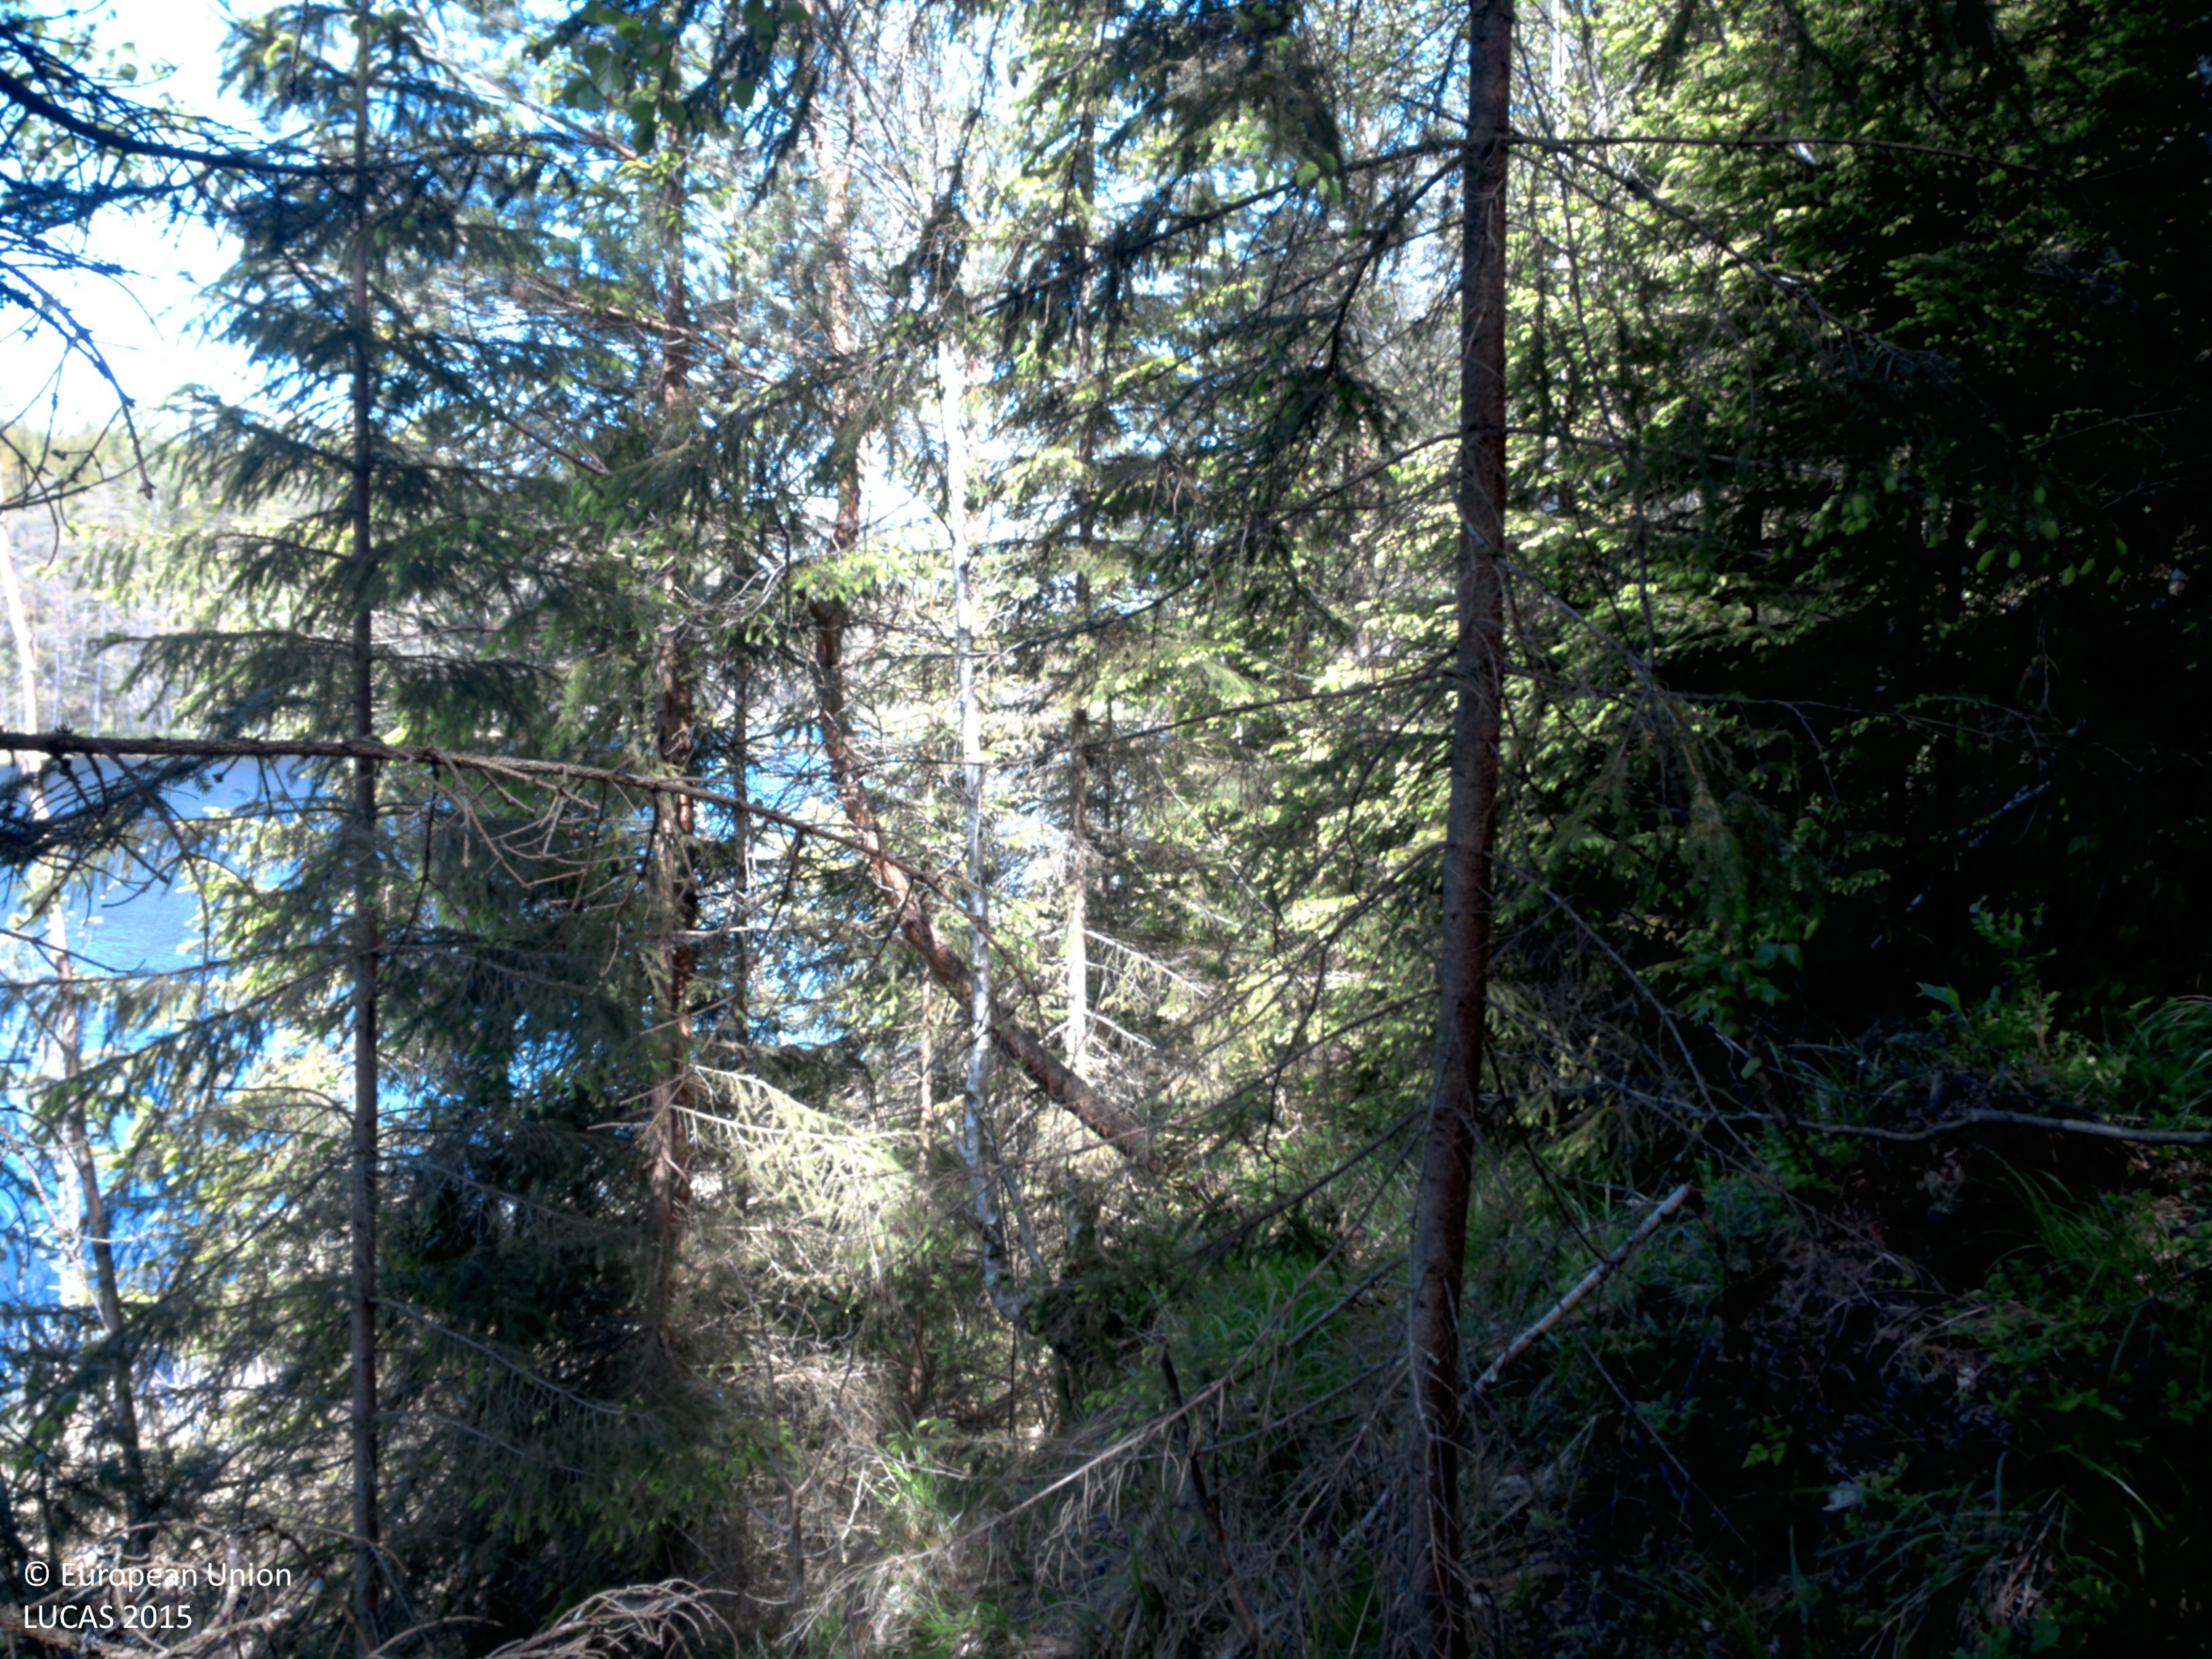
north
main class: Woodland
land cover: Spruce dominated mixed woodland
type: boreal forest
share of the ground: > 75 %
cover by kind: coniferous forest trees 60 %, broadleaved forest trees 25 %, herbaceous plants 10 %, shrubs 5 %
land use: Forestry
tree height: > 5 m
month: June
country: SE
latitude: 59.0988
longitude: 12.3513
